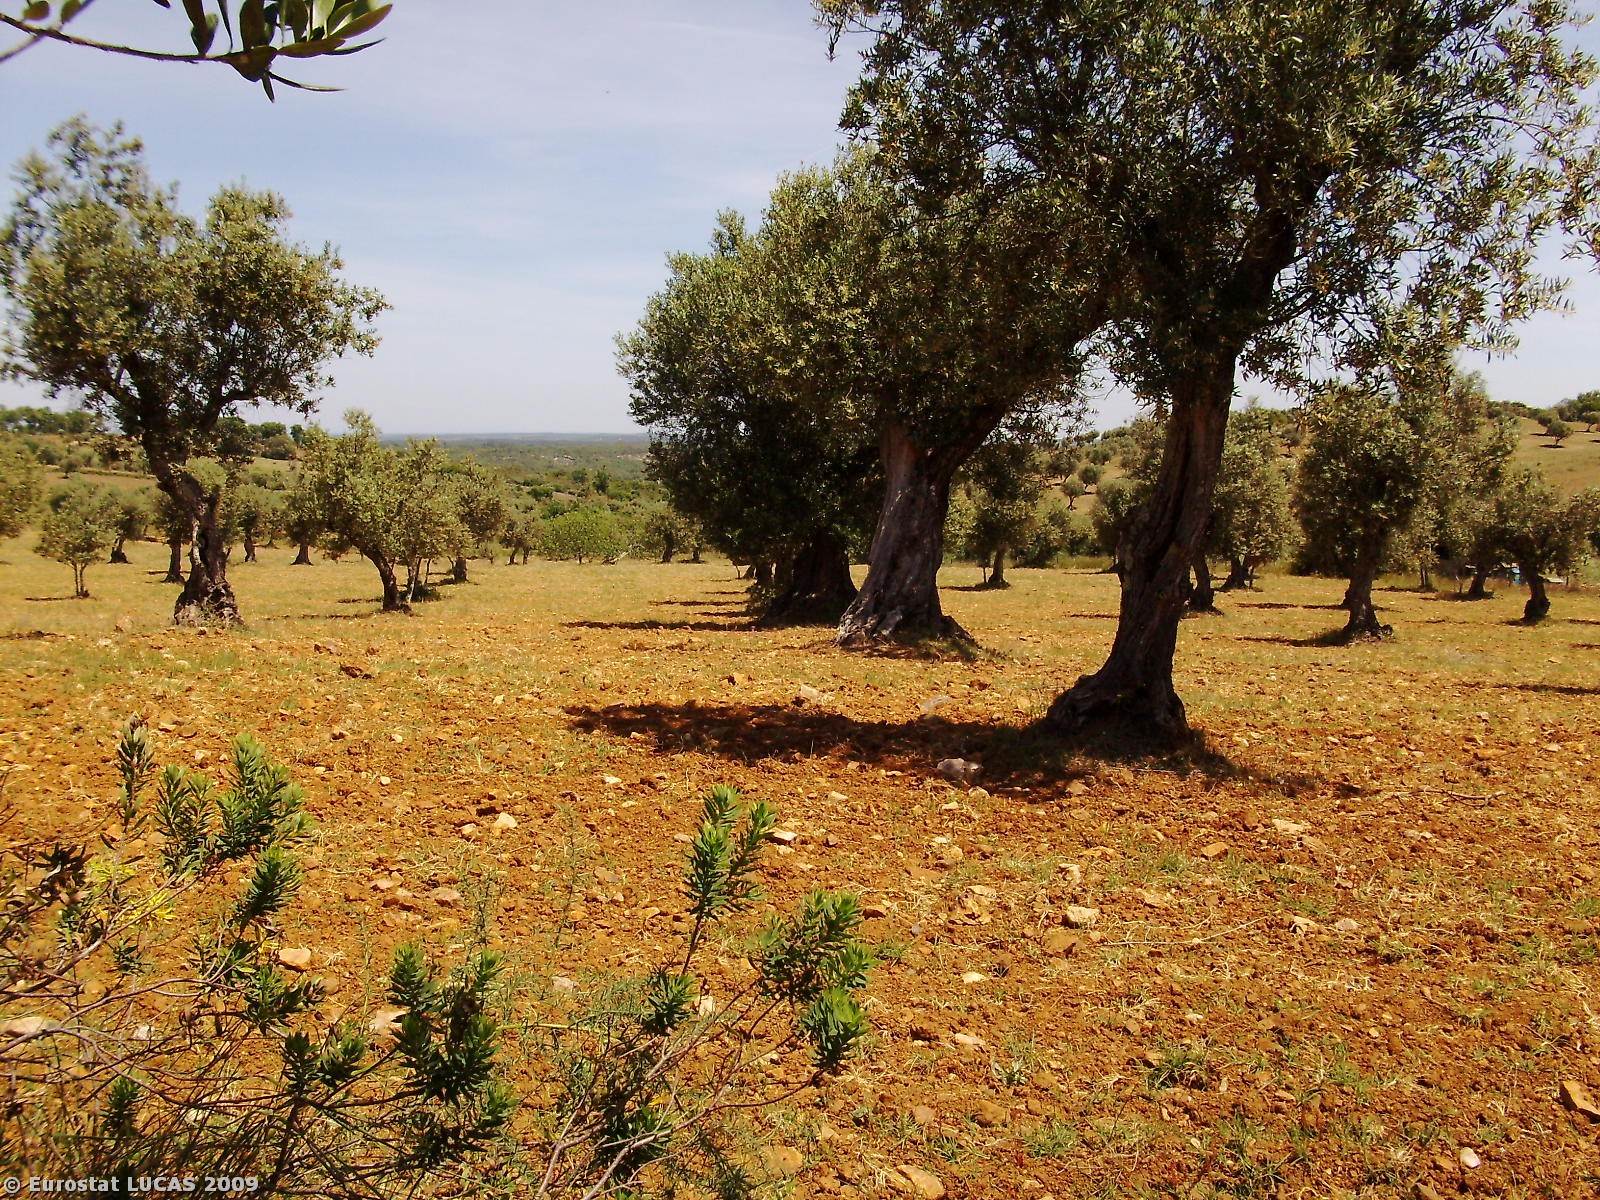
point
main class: Cropland
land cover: Olive groves
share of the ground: 50 - 75 %
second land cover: Bare land
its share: 25 - 50 %
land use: Agriculture (excluding fallow land and kitchen gardens)
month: May
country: PT
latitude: 39.1638
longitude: -7.9797
